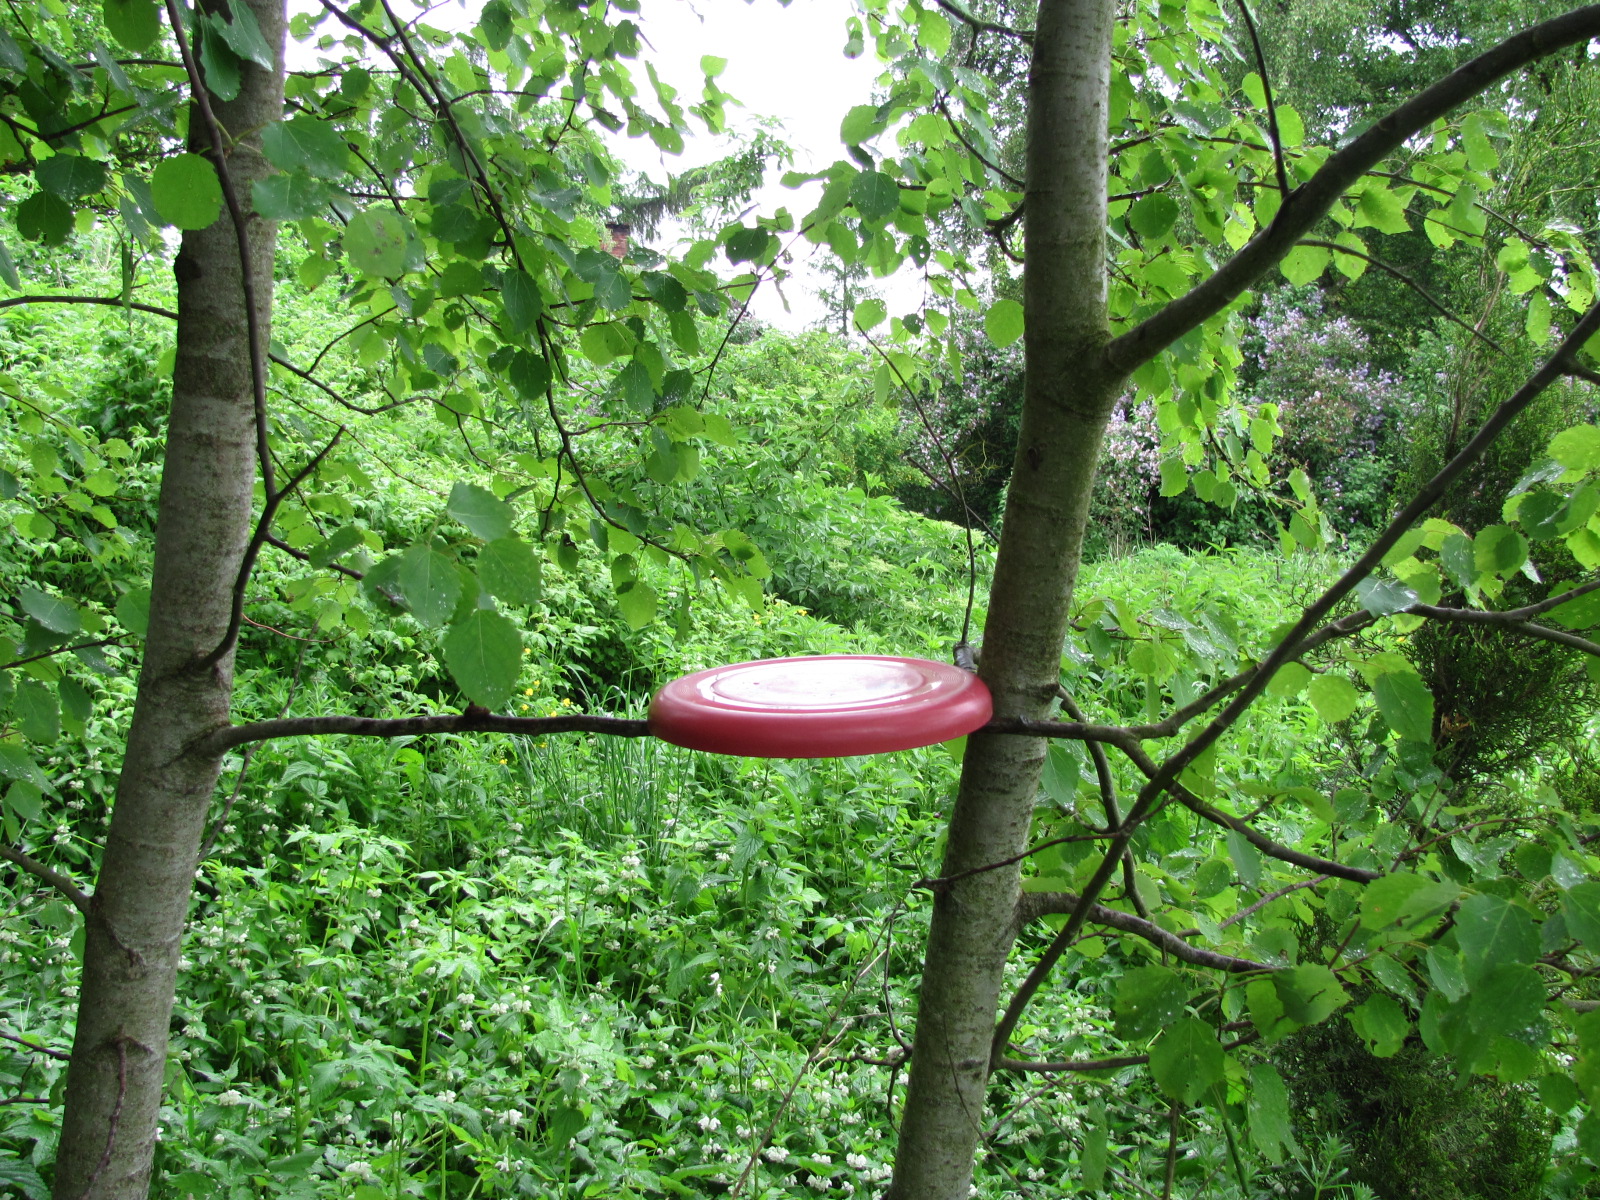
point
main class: Woodland
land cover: Broadleaved woodland
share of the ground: > 75 %
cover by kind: broadleaved forest trees 100 %
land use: Residential
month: June
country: LV
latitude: 56.5951
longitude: 24.2425
